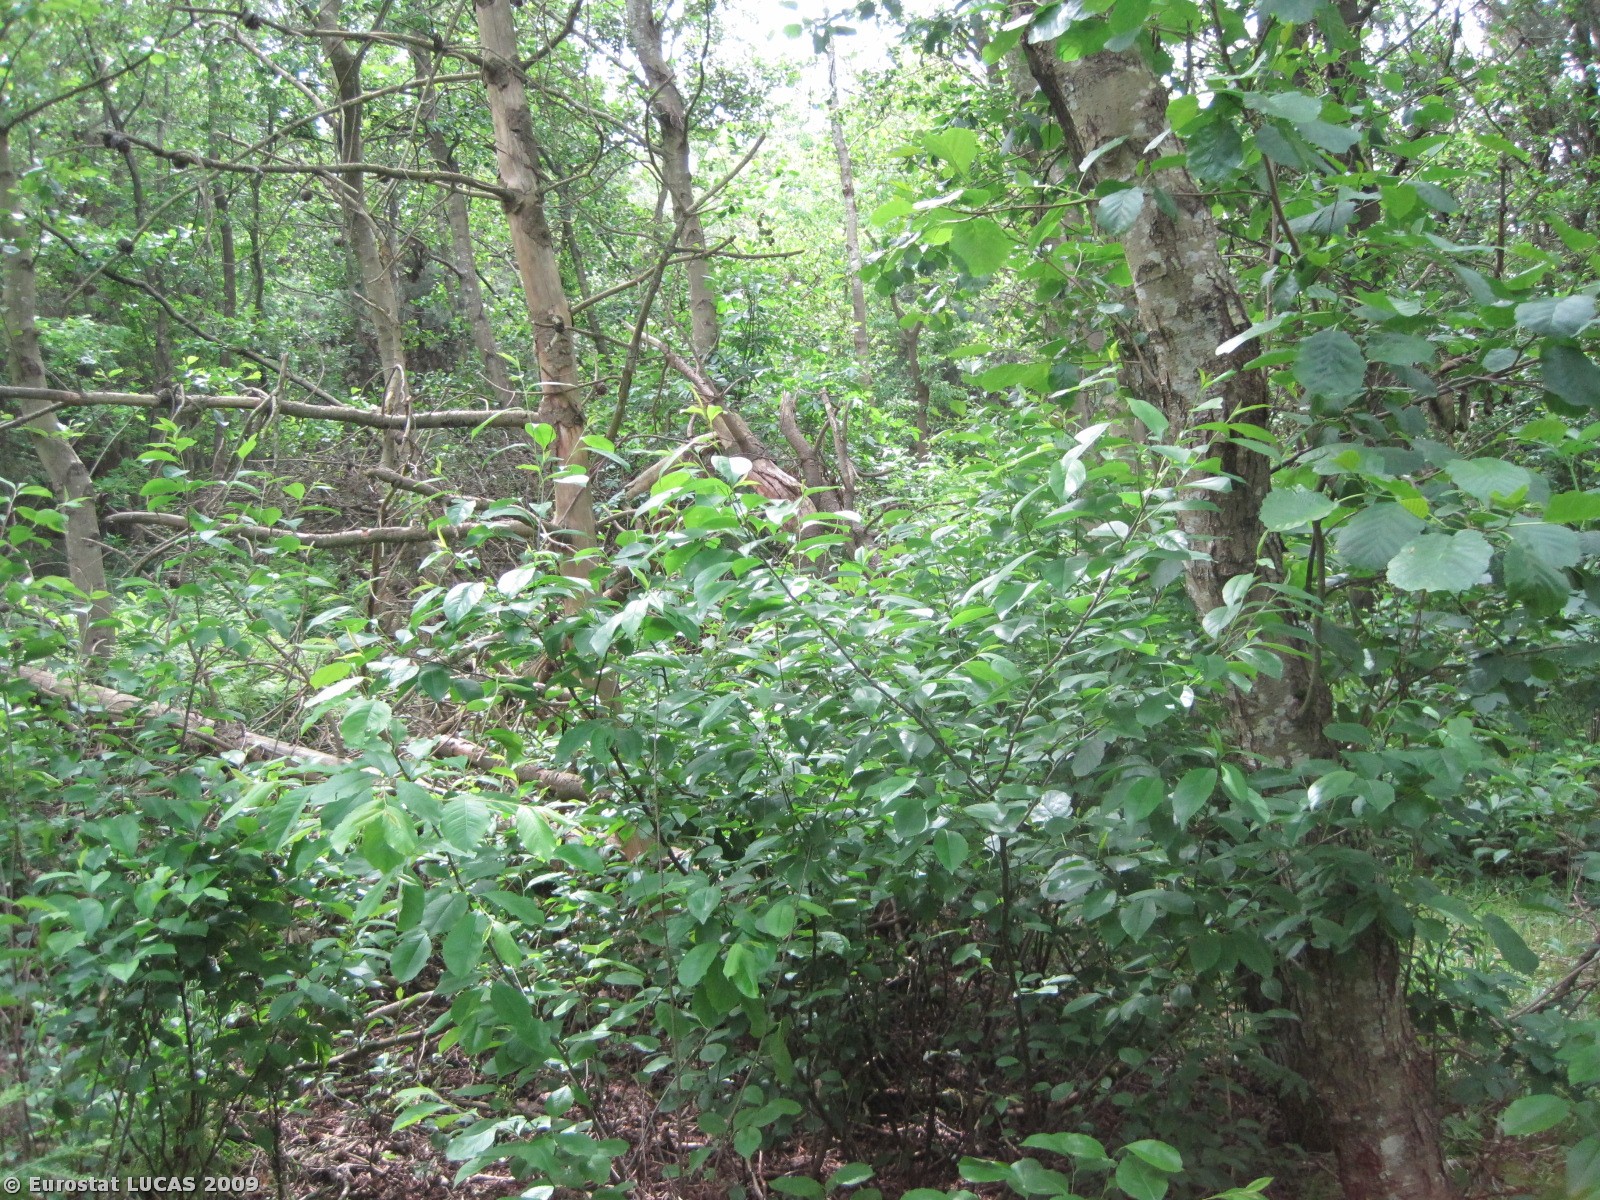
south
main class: Woodland
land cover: Mixed woodland
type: plantations and self-sown exotic forest
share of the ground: 50 - 75 %
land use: Forestry
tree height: > 5 m
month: June
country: DK
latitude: 57.3560
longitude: 9.7179
